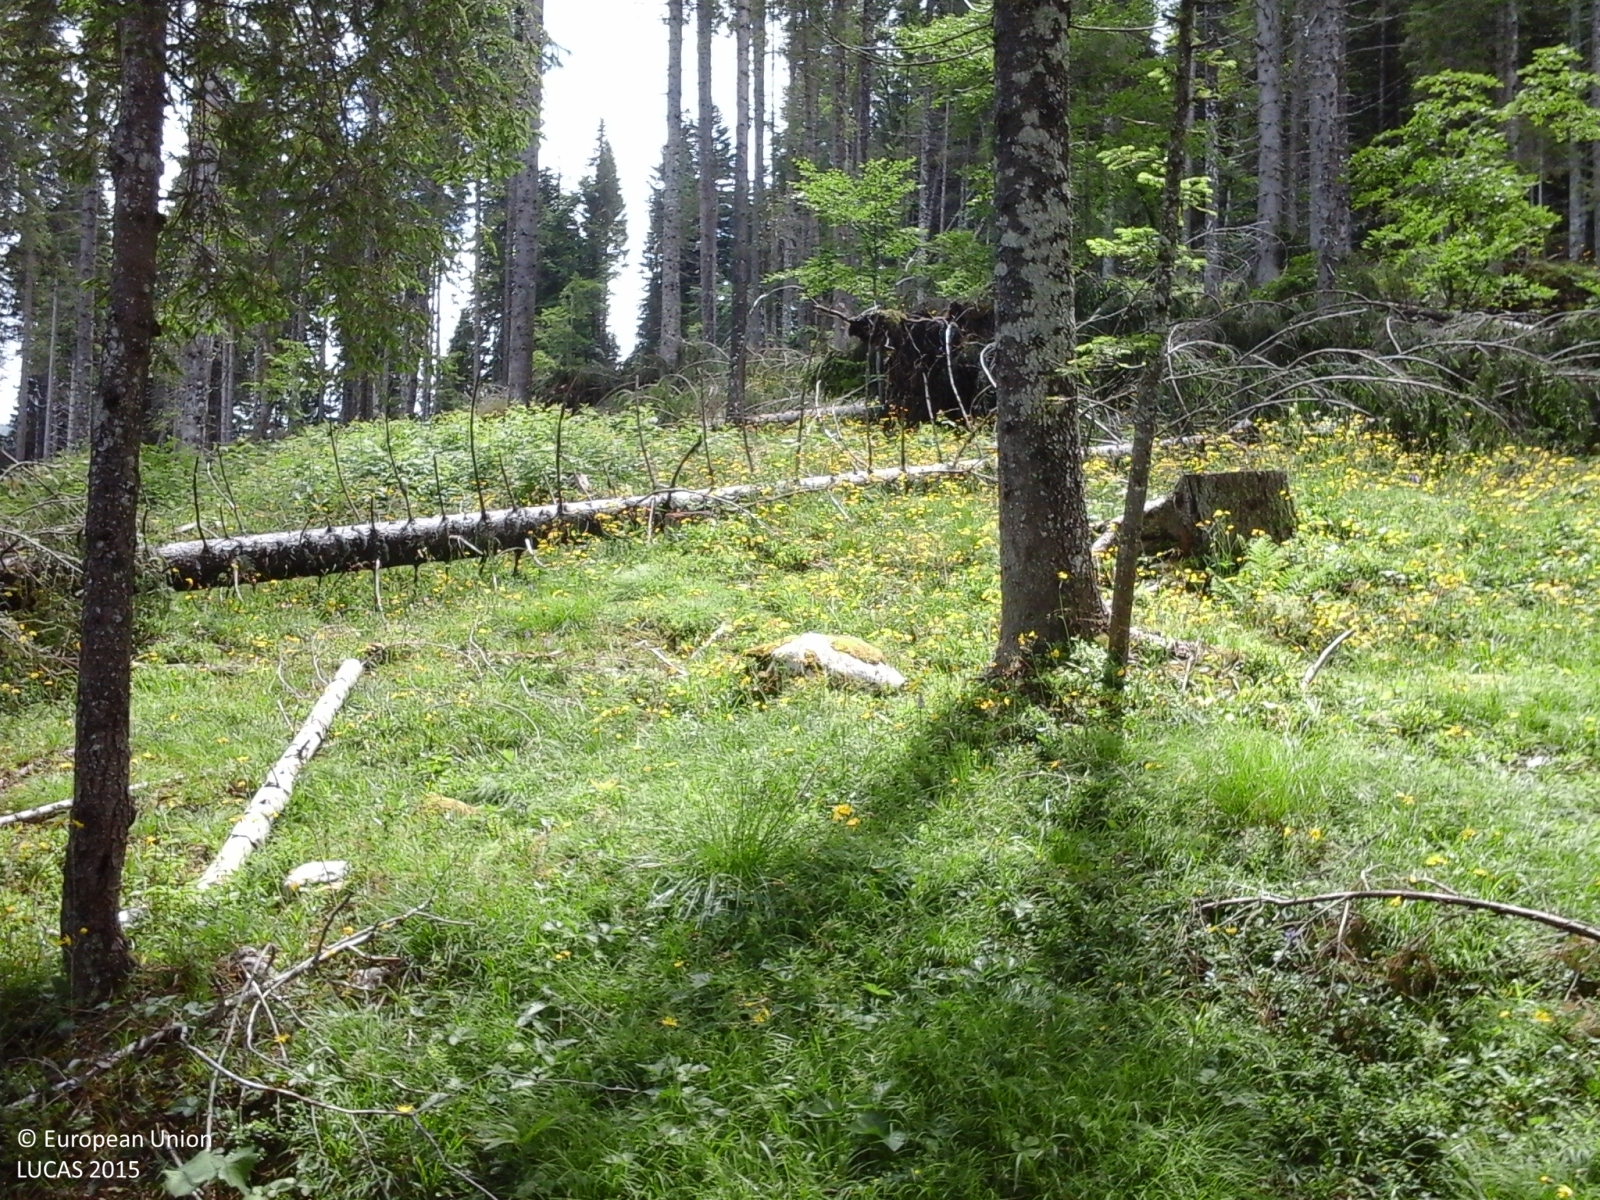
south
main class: Woodland
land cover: Spruce dominated coniferous woodland
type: alpine coniferous forest
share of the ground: > 75 %
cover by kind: coniferous forest trees 100 %
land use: Forestry
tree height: > 5 m
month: June
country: IT
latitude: 45.9431
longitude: 11.5843
